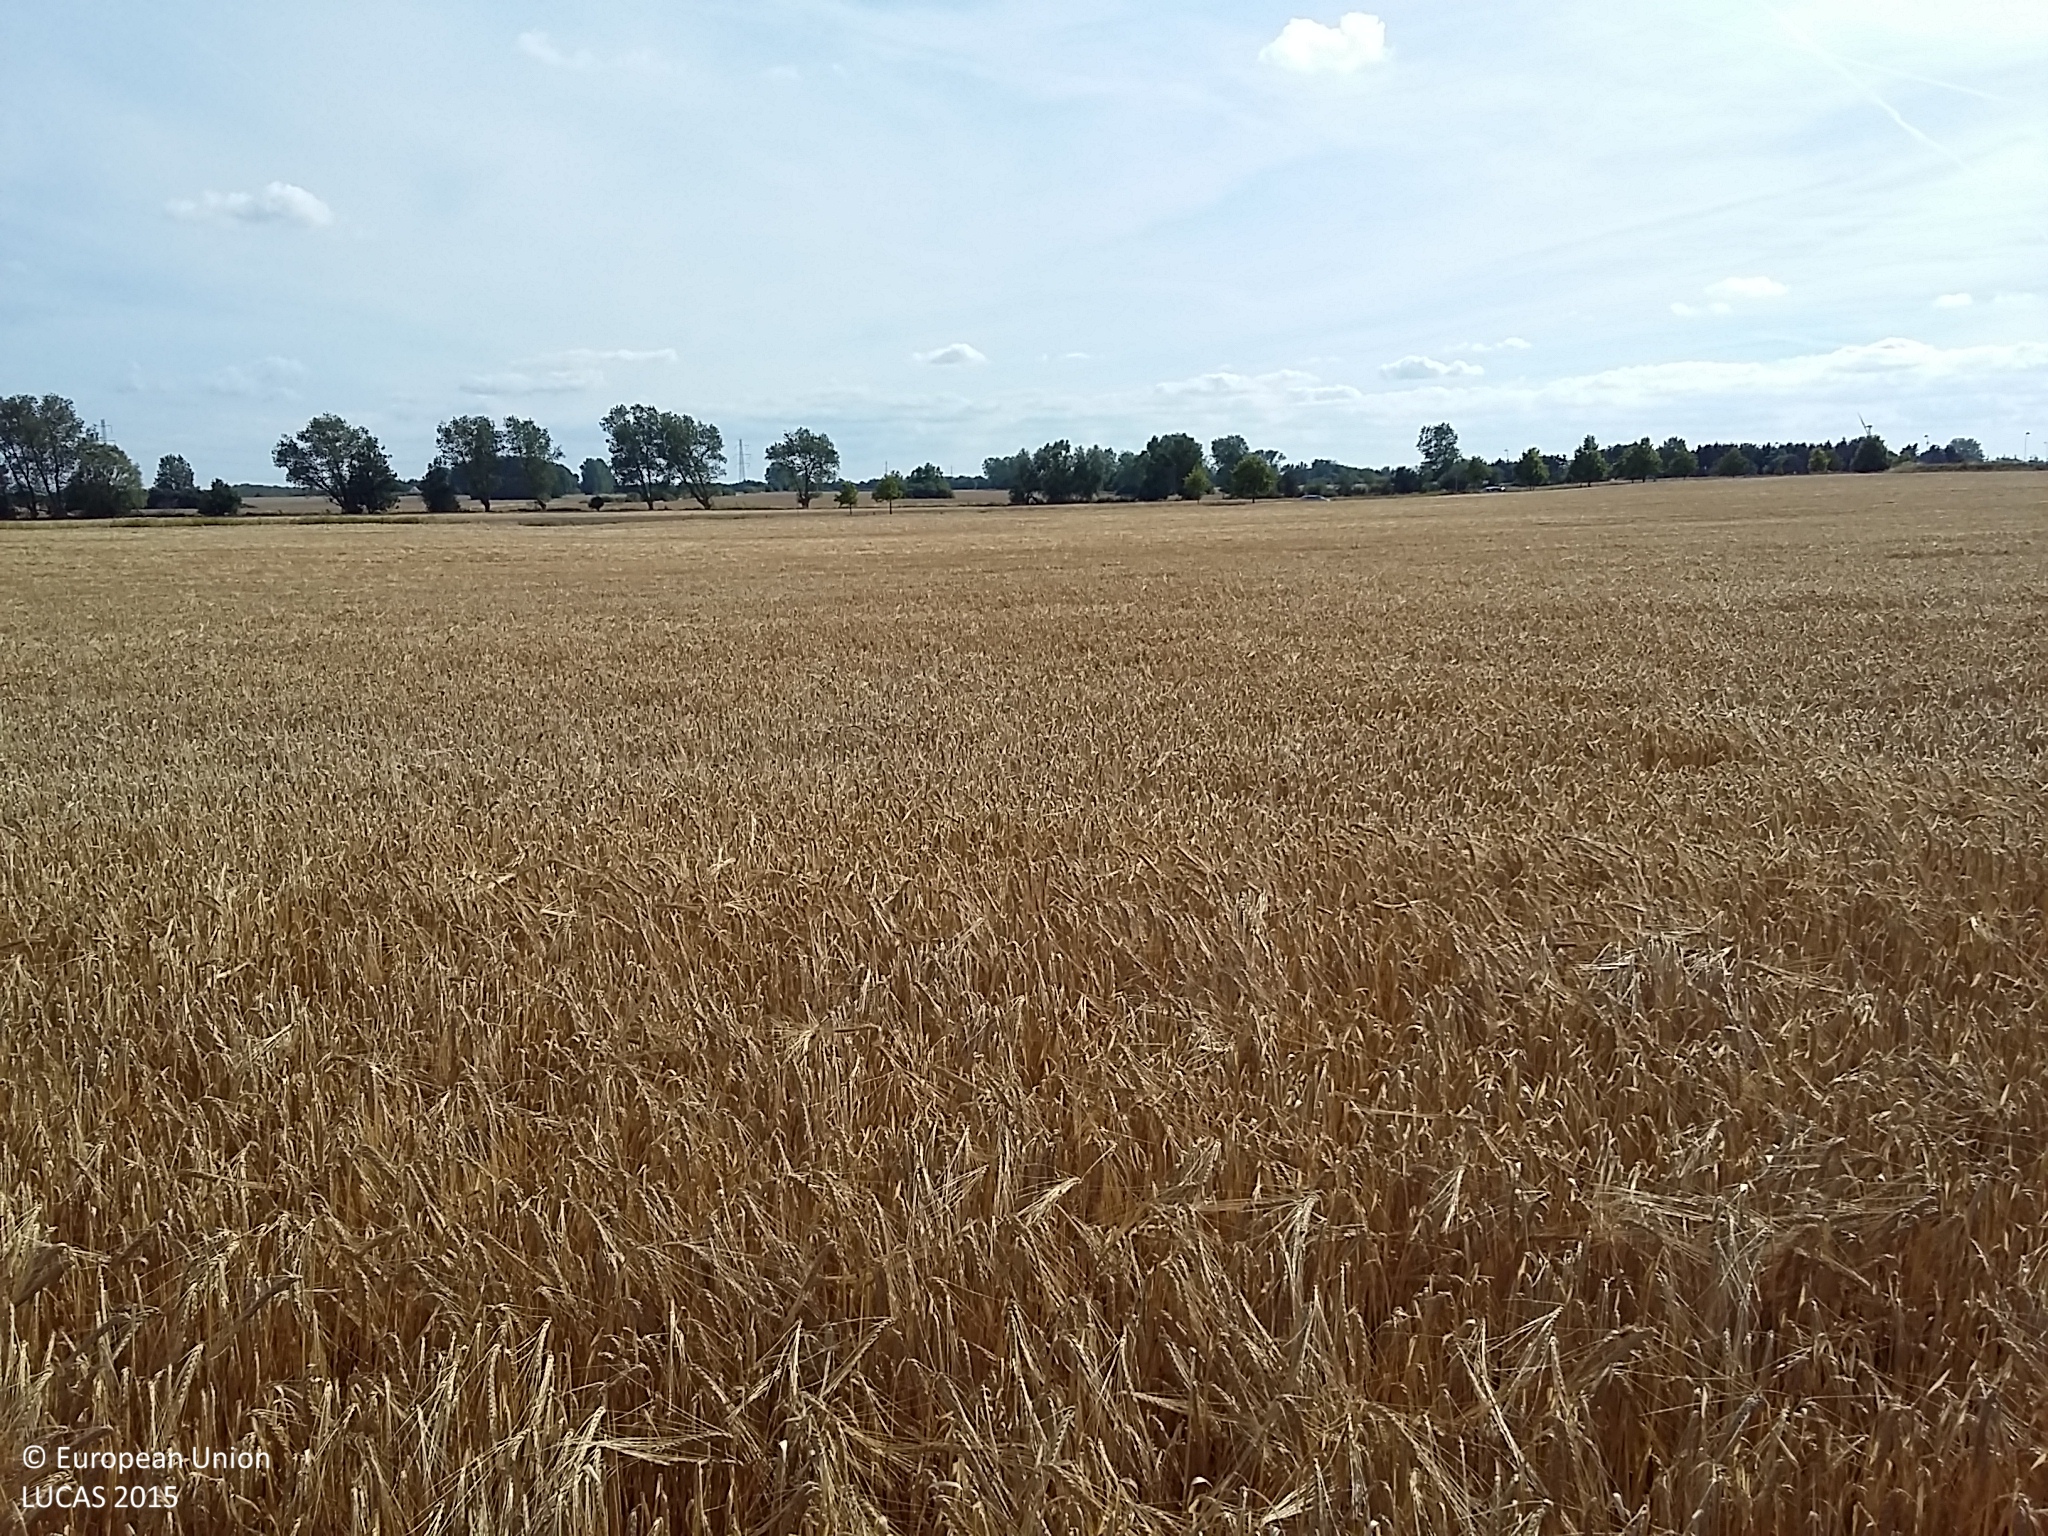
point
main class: Cropland
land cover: Barley
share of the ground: > 75 %
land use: Agriculture (excluding fallow land and kitchen gardens)
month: August
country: DK
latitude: 55.5406
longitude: 12.1376
